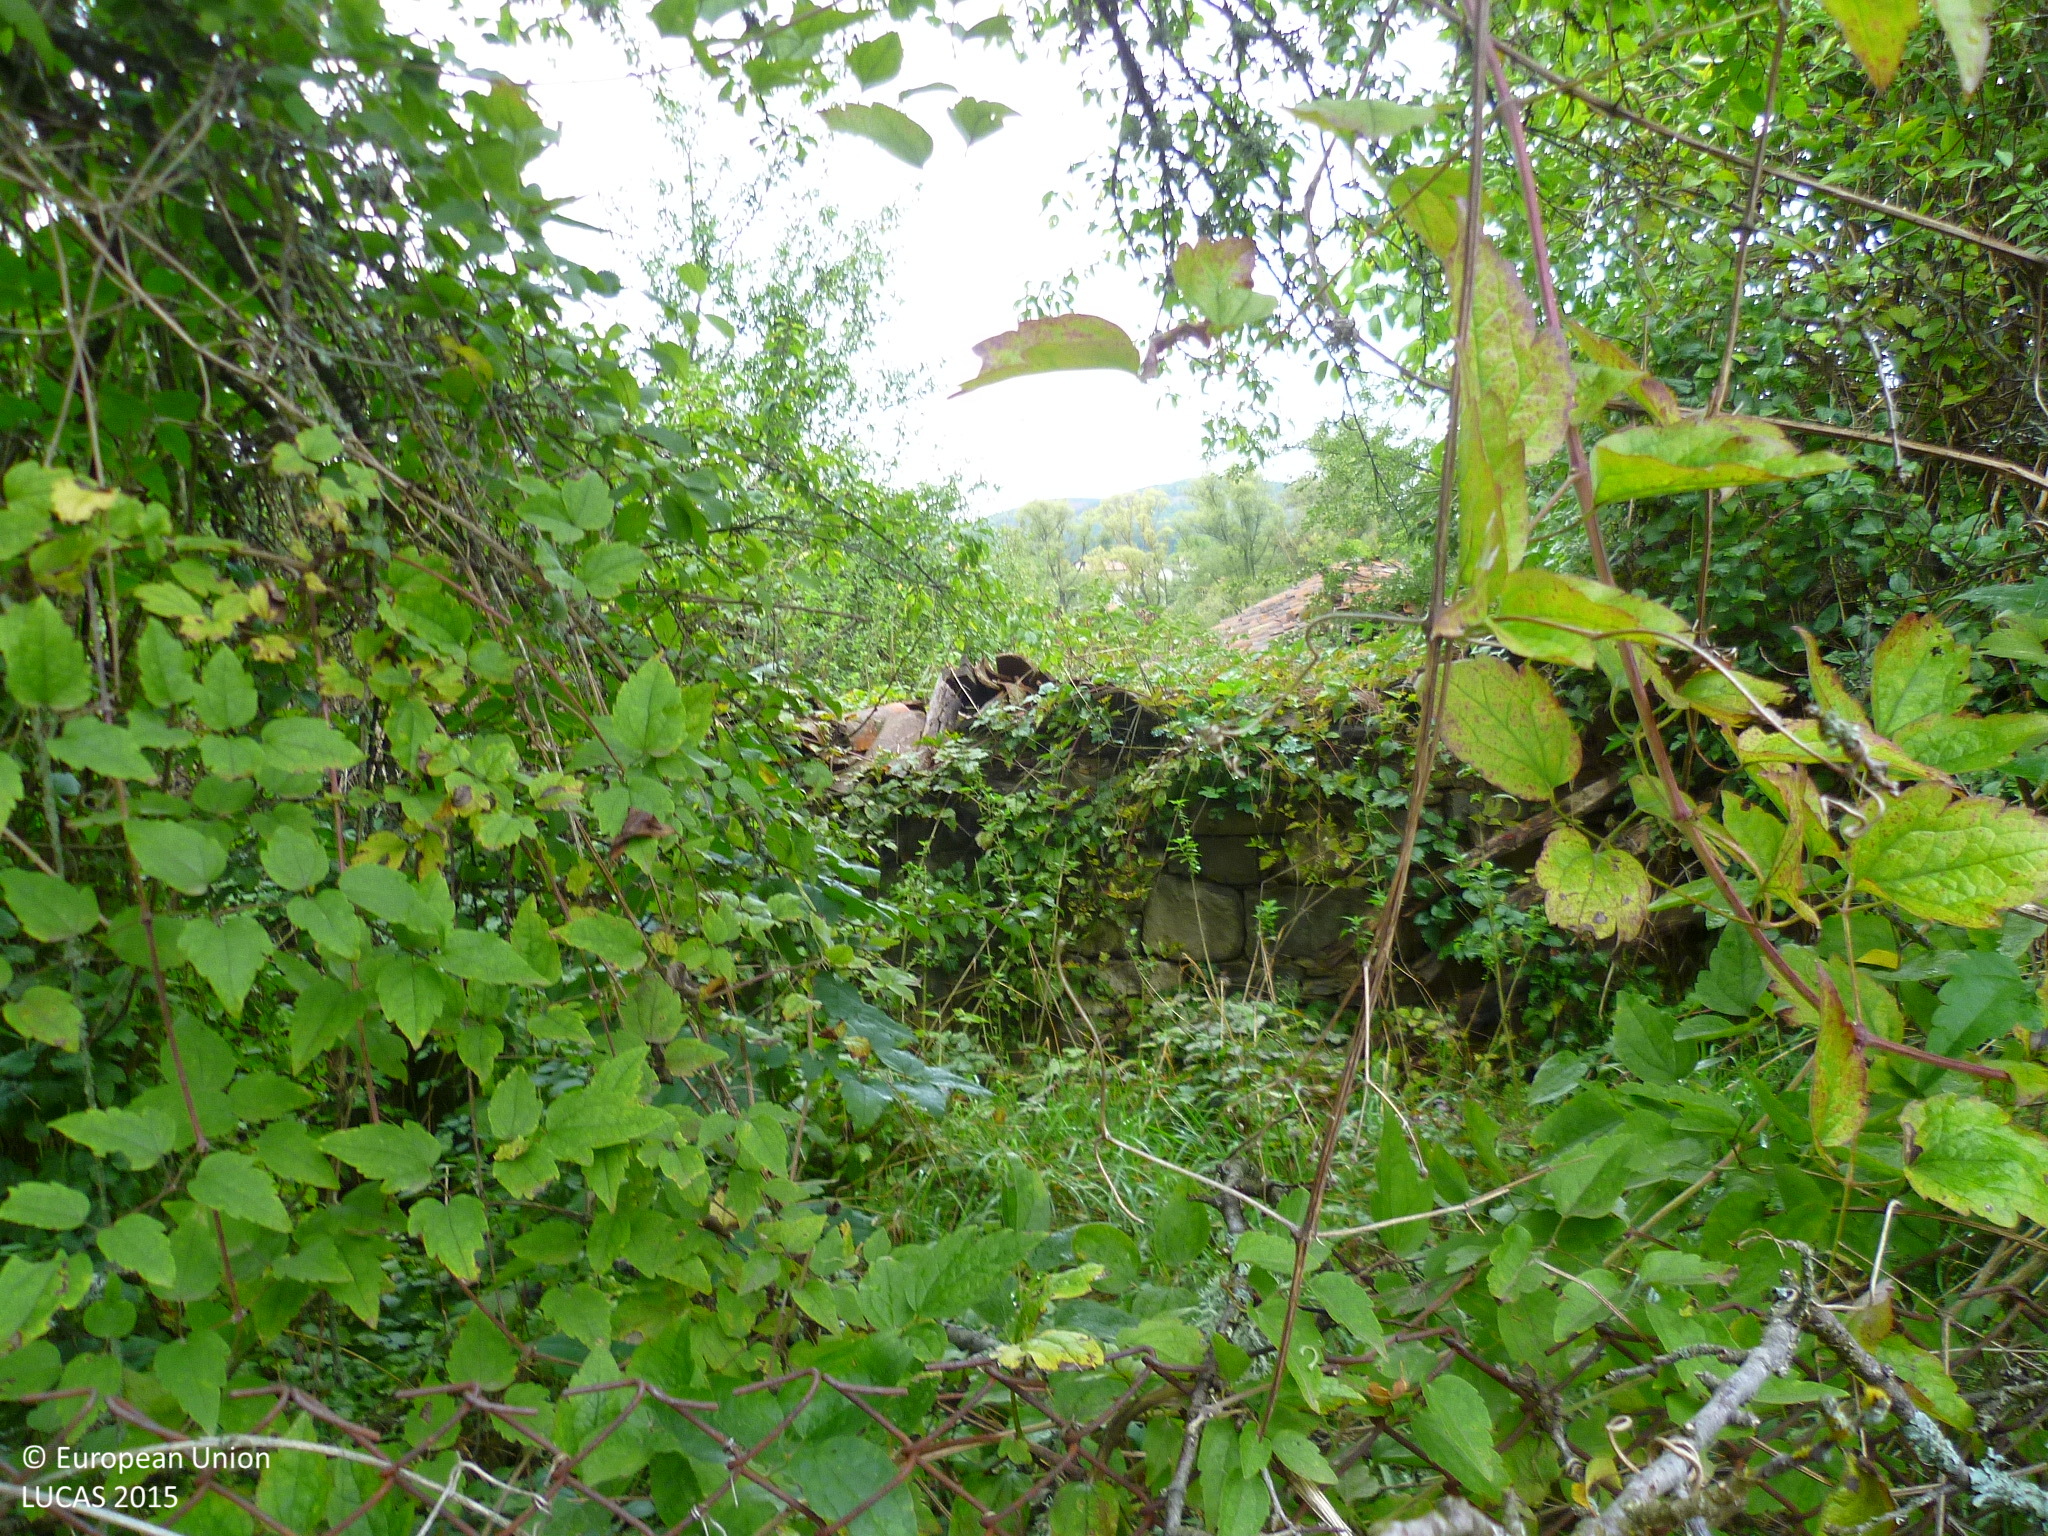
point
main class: Cropland
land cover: Nuts trees
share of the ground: 50 - 75 %
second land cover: Spontaneously vegetated surfaces
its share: 50 - 75 %
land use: Kitchen garden
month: September
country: BG
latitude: 42.6691
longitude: 22.7276
